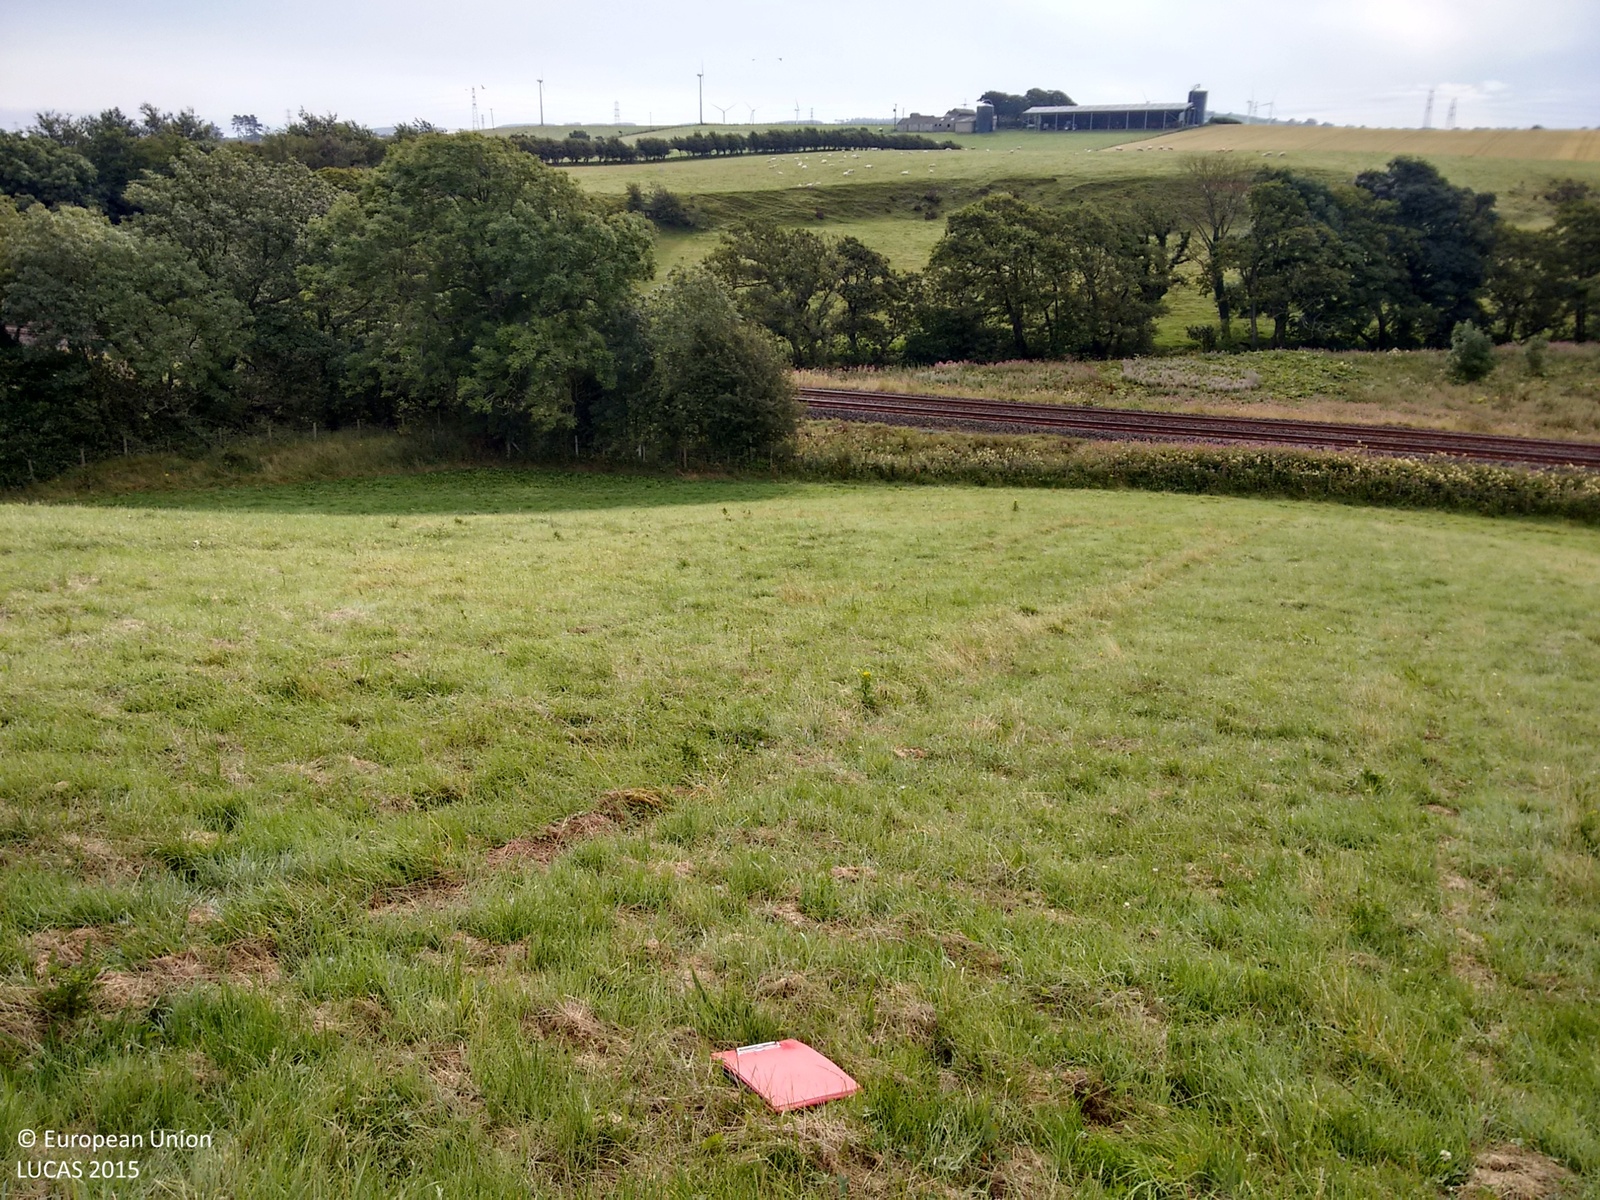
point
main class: Grassland
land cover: Grassland without tree/shrub cover
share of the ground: > 75 %
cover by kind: herbaceous plants 100 %
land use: Agriculture (excluding fallow land and kitchen gardens)
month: August
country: GB
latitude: 54.7303
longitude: -3.4191
